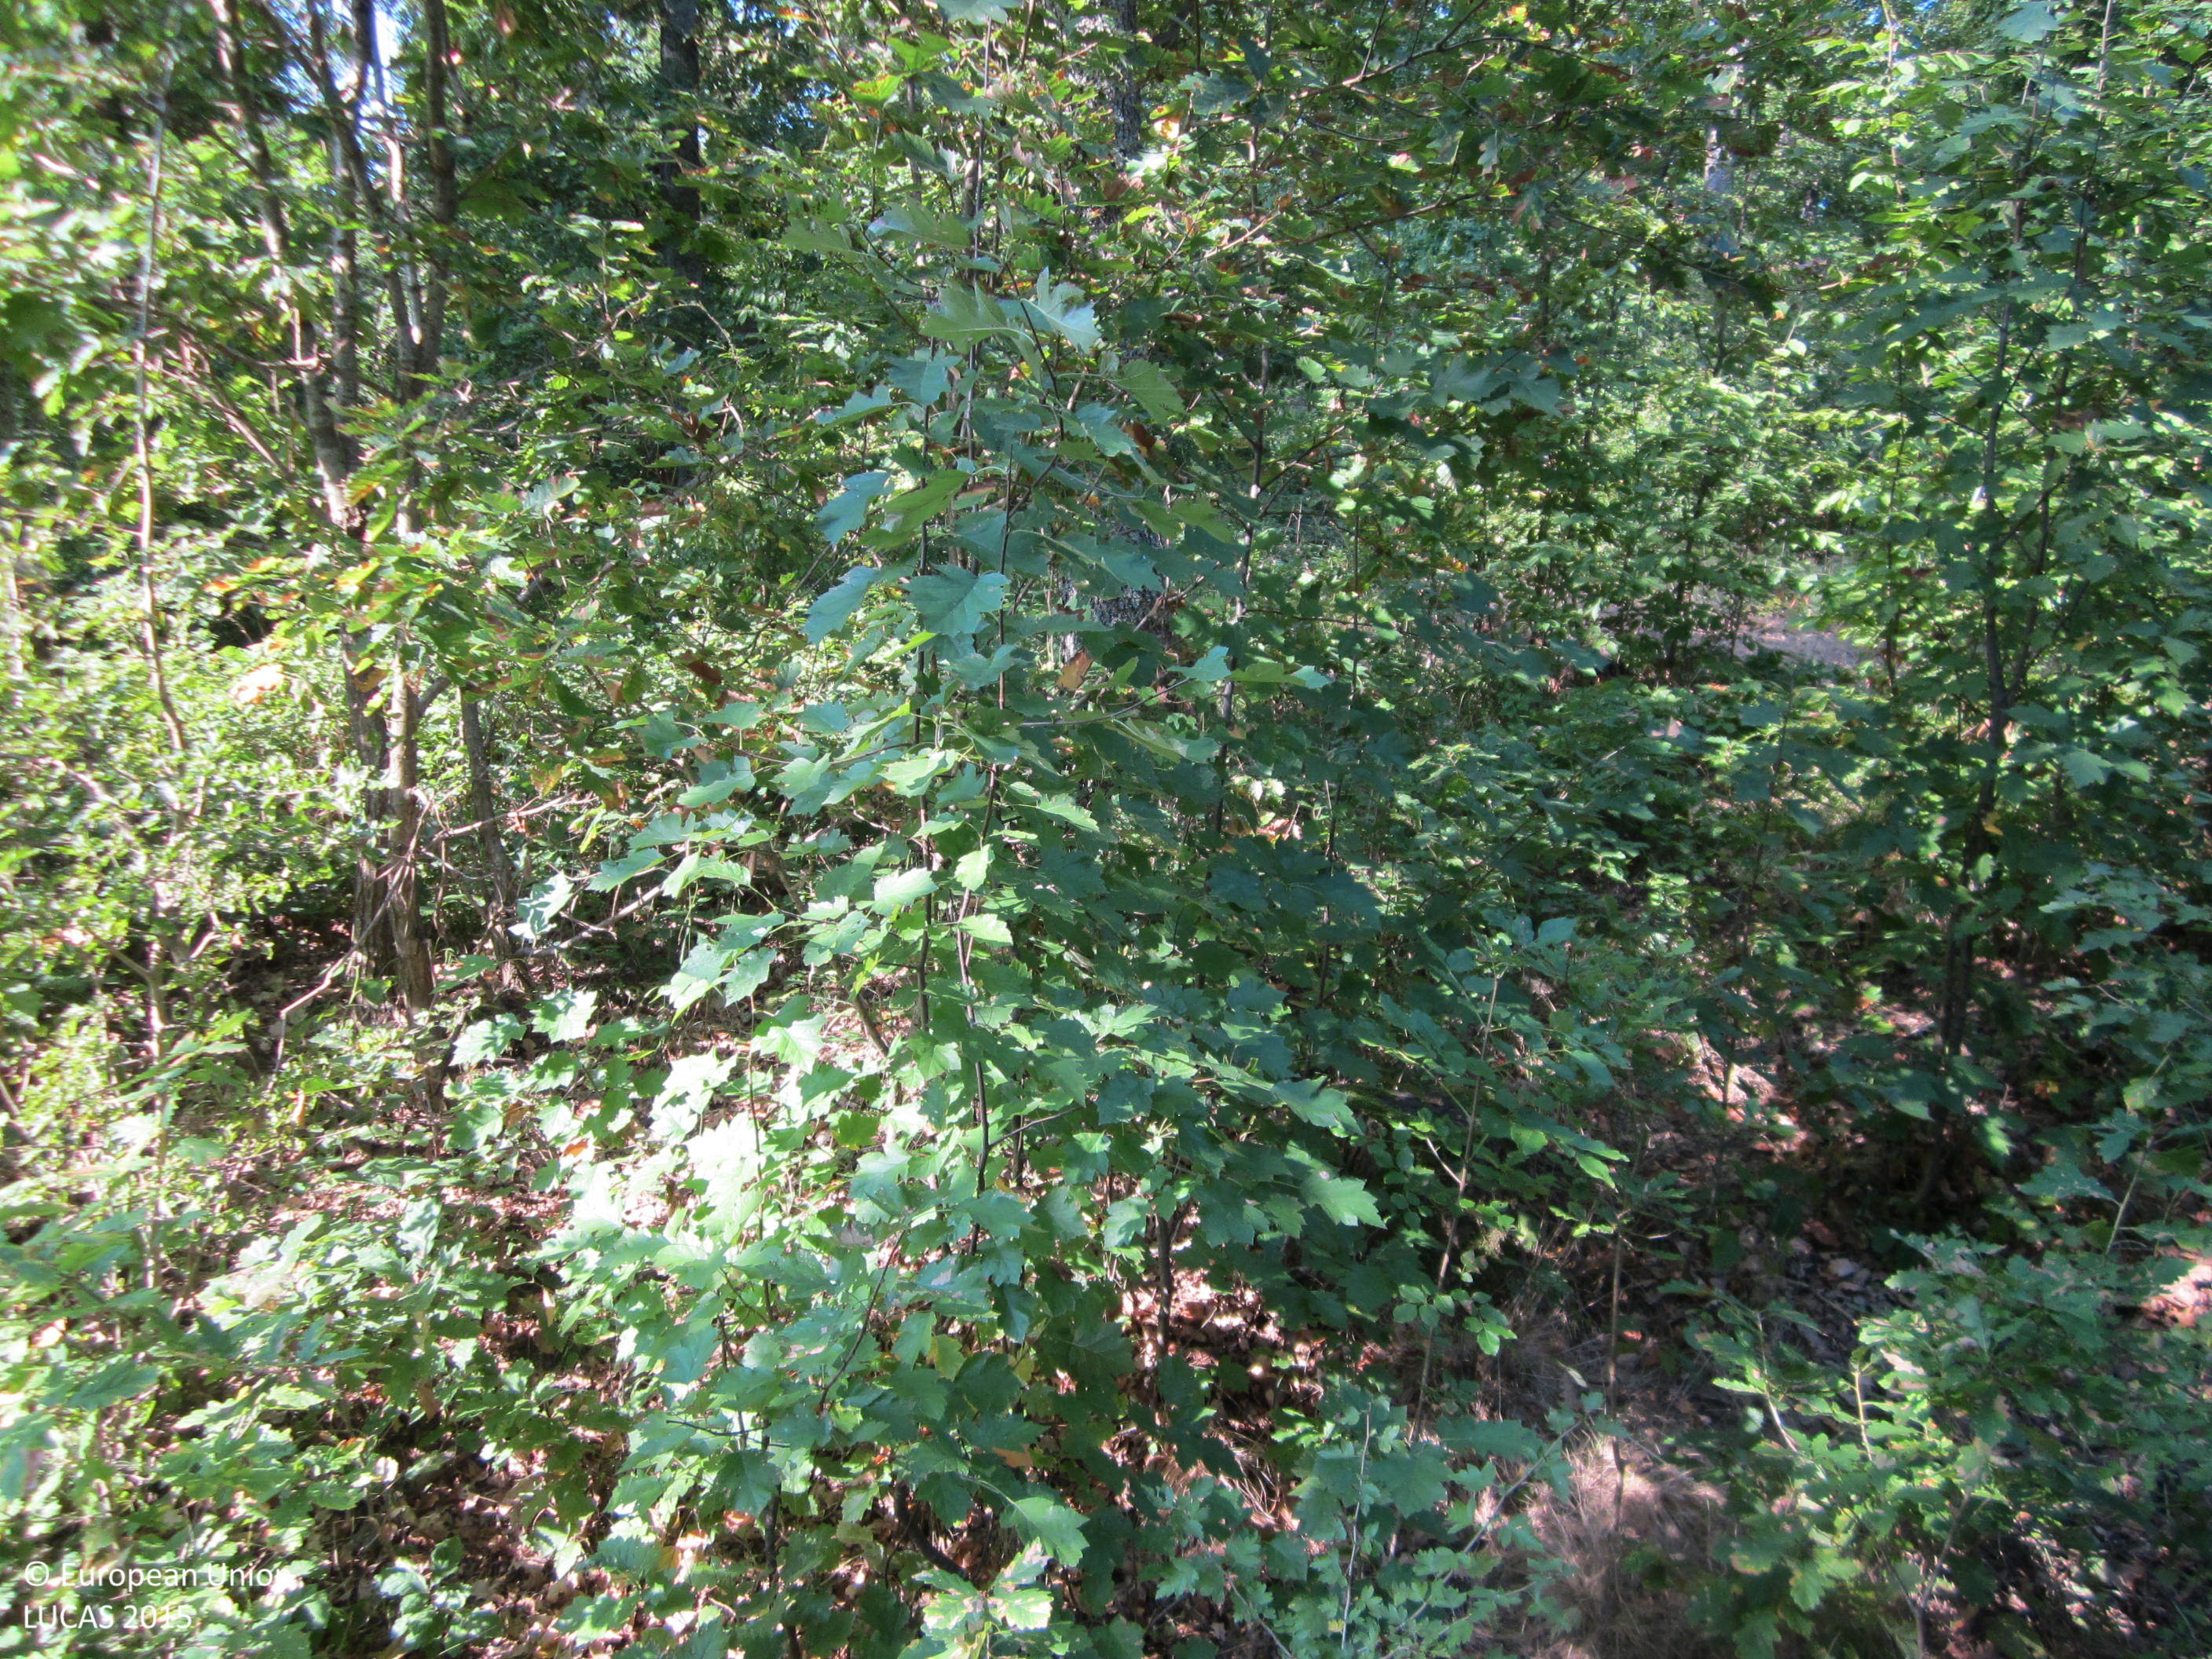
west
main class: Woodland
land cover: Broadleaved woodland
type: mesophytic deciduous forest
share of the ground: > 75 %
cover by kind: broadleaved forest trees 85 %, herbaceous plants 10 %, shrubs 5 %
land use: Forestry
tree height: > 5 m
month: September
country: BG
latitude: 42.8630
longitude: 27.3143
